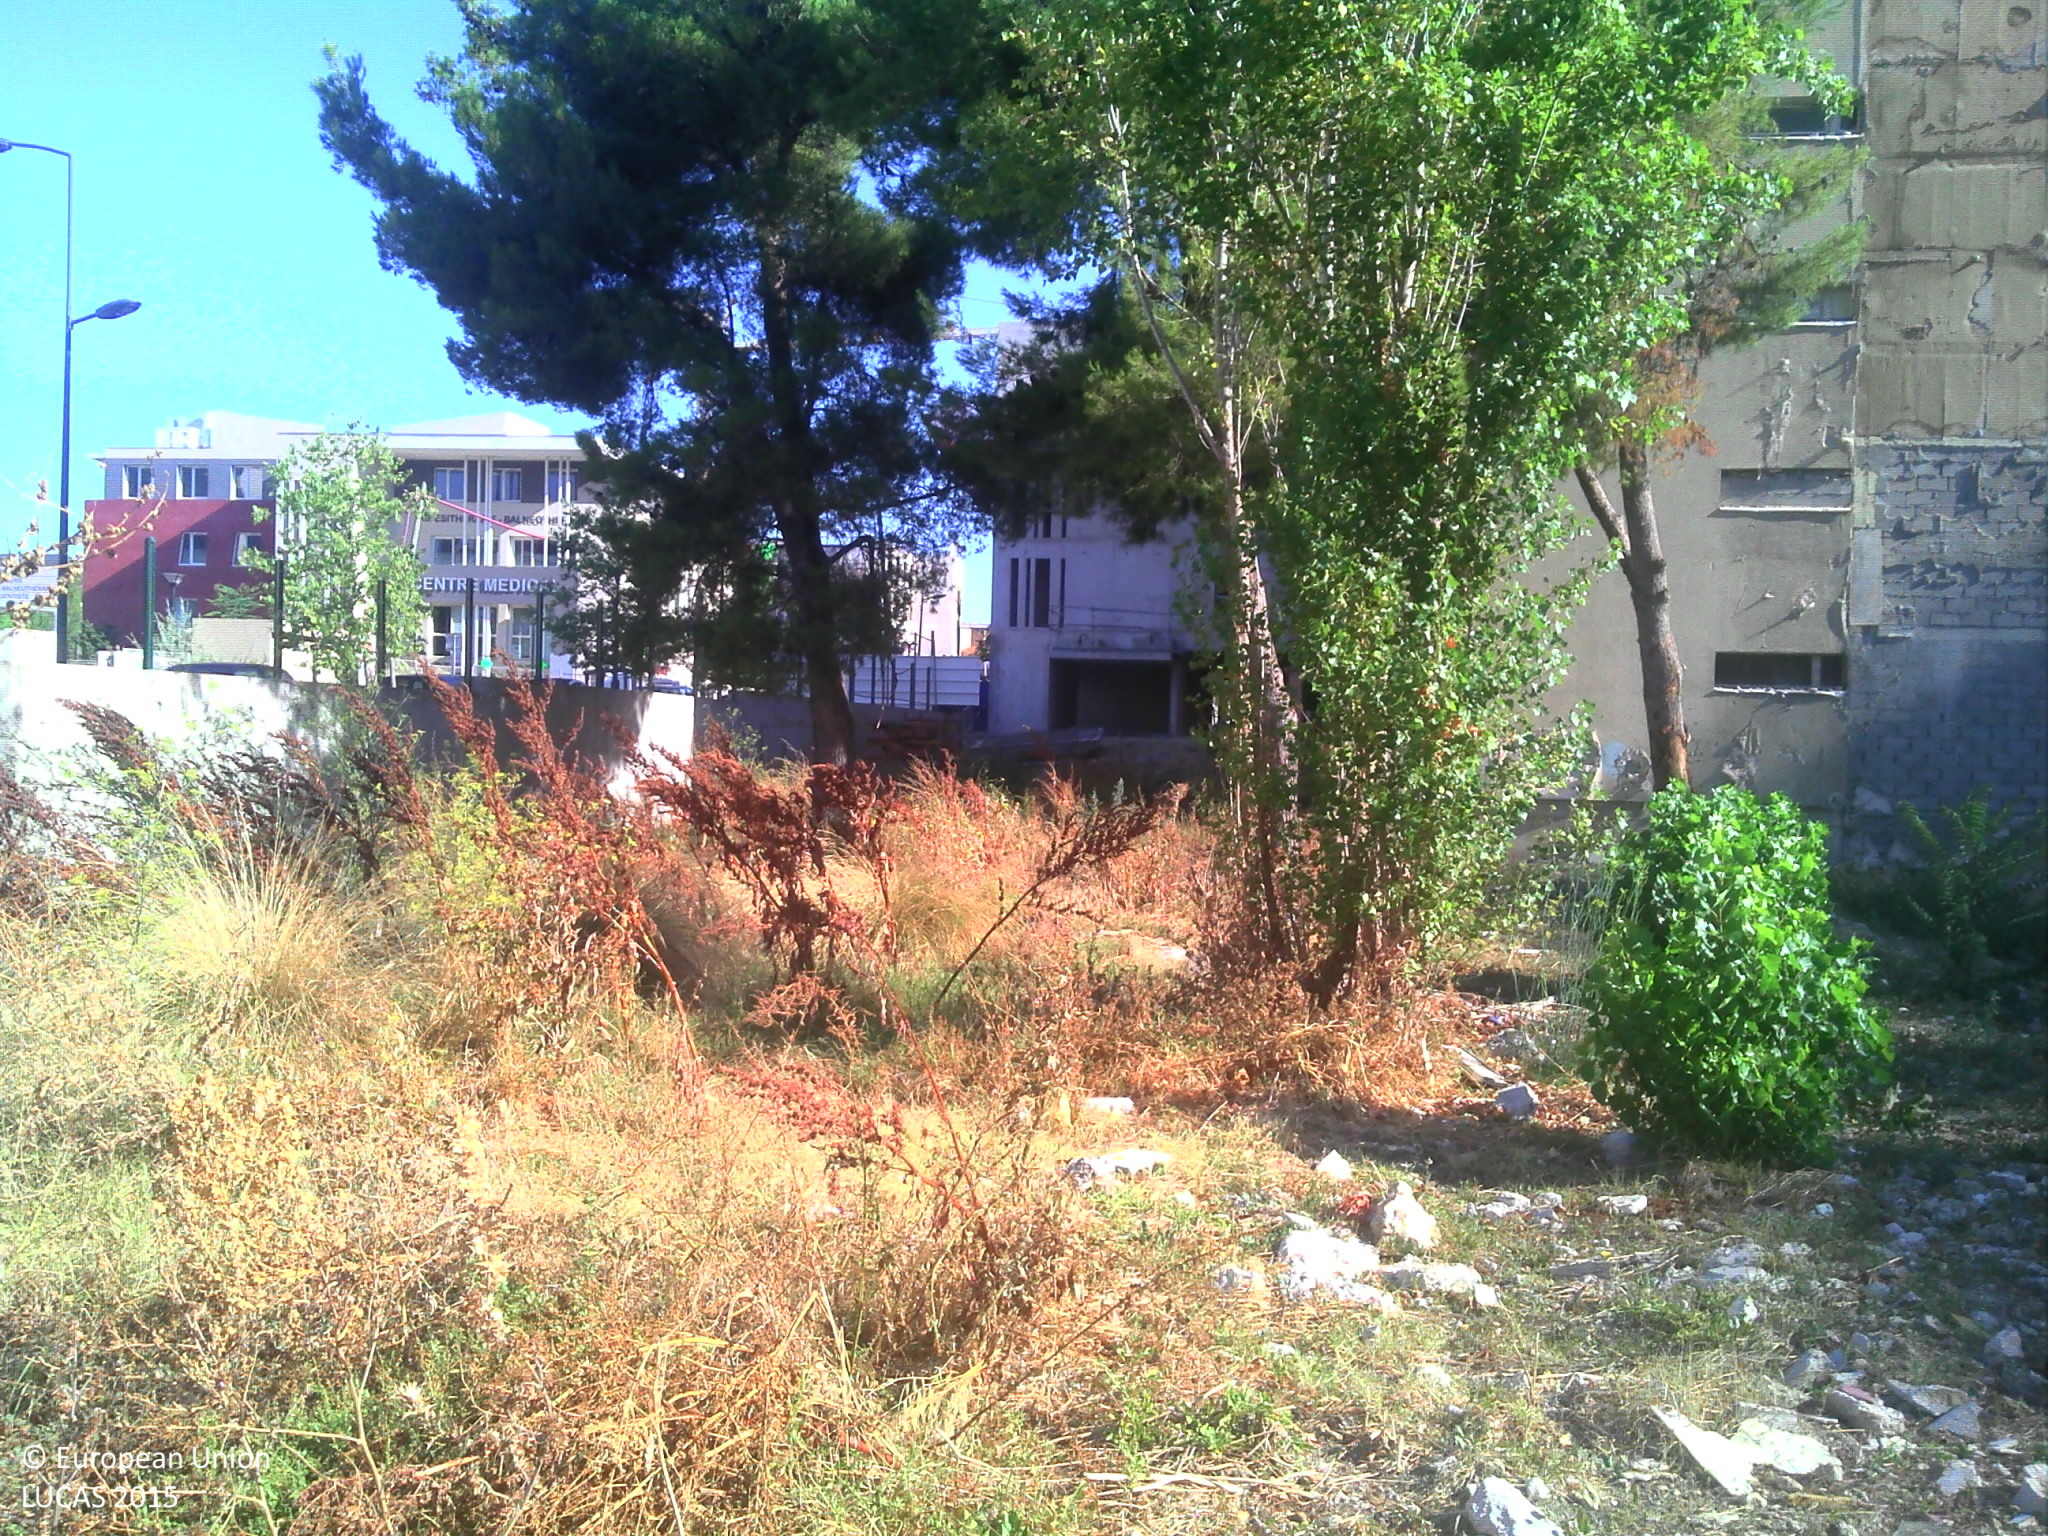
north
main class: Grassland
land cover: Grassland with sparse tree/shrub cover
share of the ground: 50 - 75 %
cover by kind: consolidated bare surface 40 %, unconsolidated bare surface 30 %, herbaceous plants 20 %, broadleaved forest trees 5 %, shrubs 5 %
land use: Abandoned areas
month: August
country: FR
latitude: 43.3275
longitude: 5.4103
